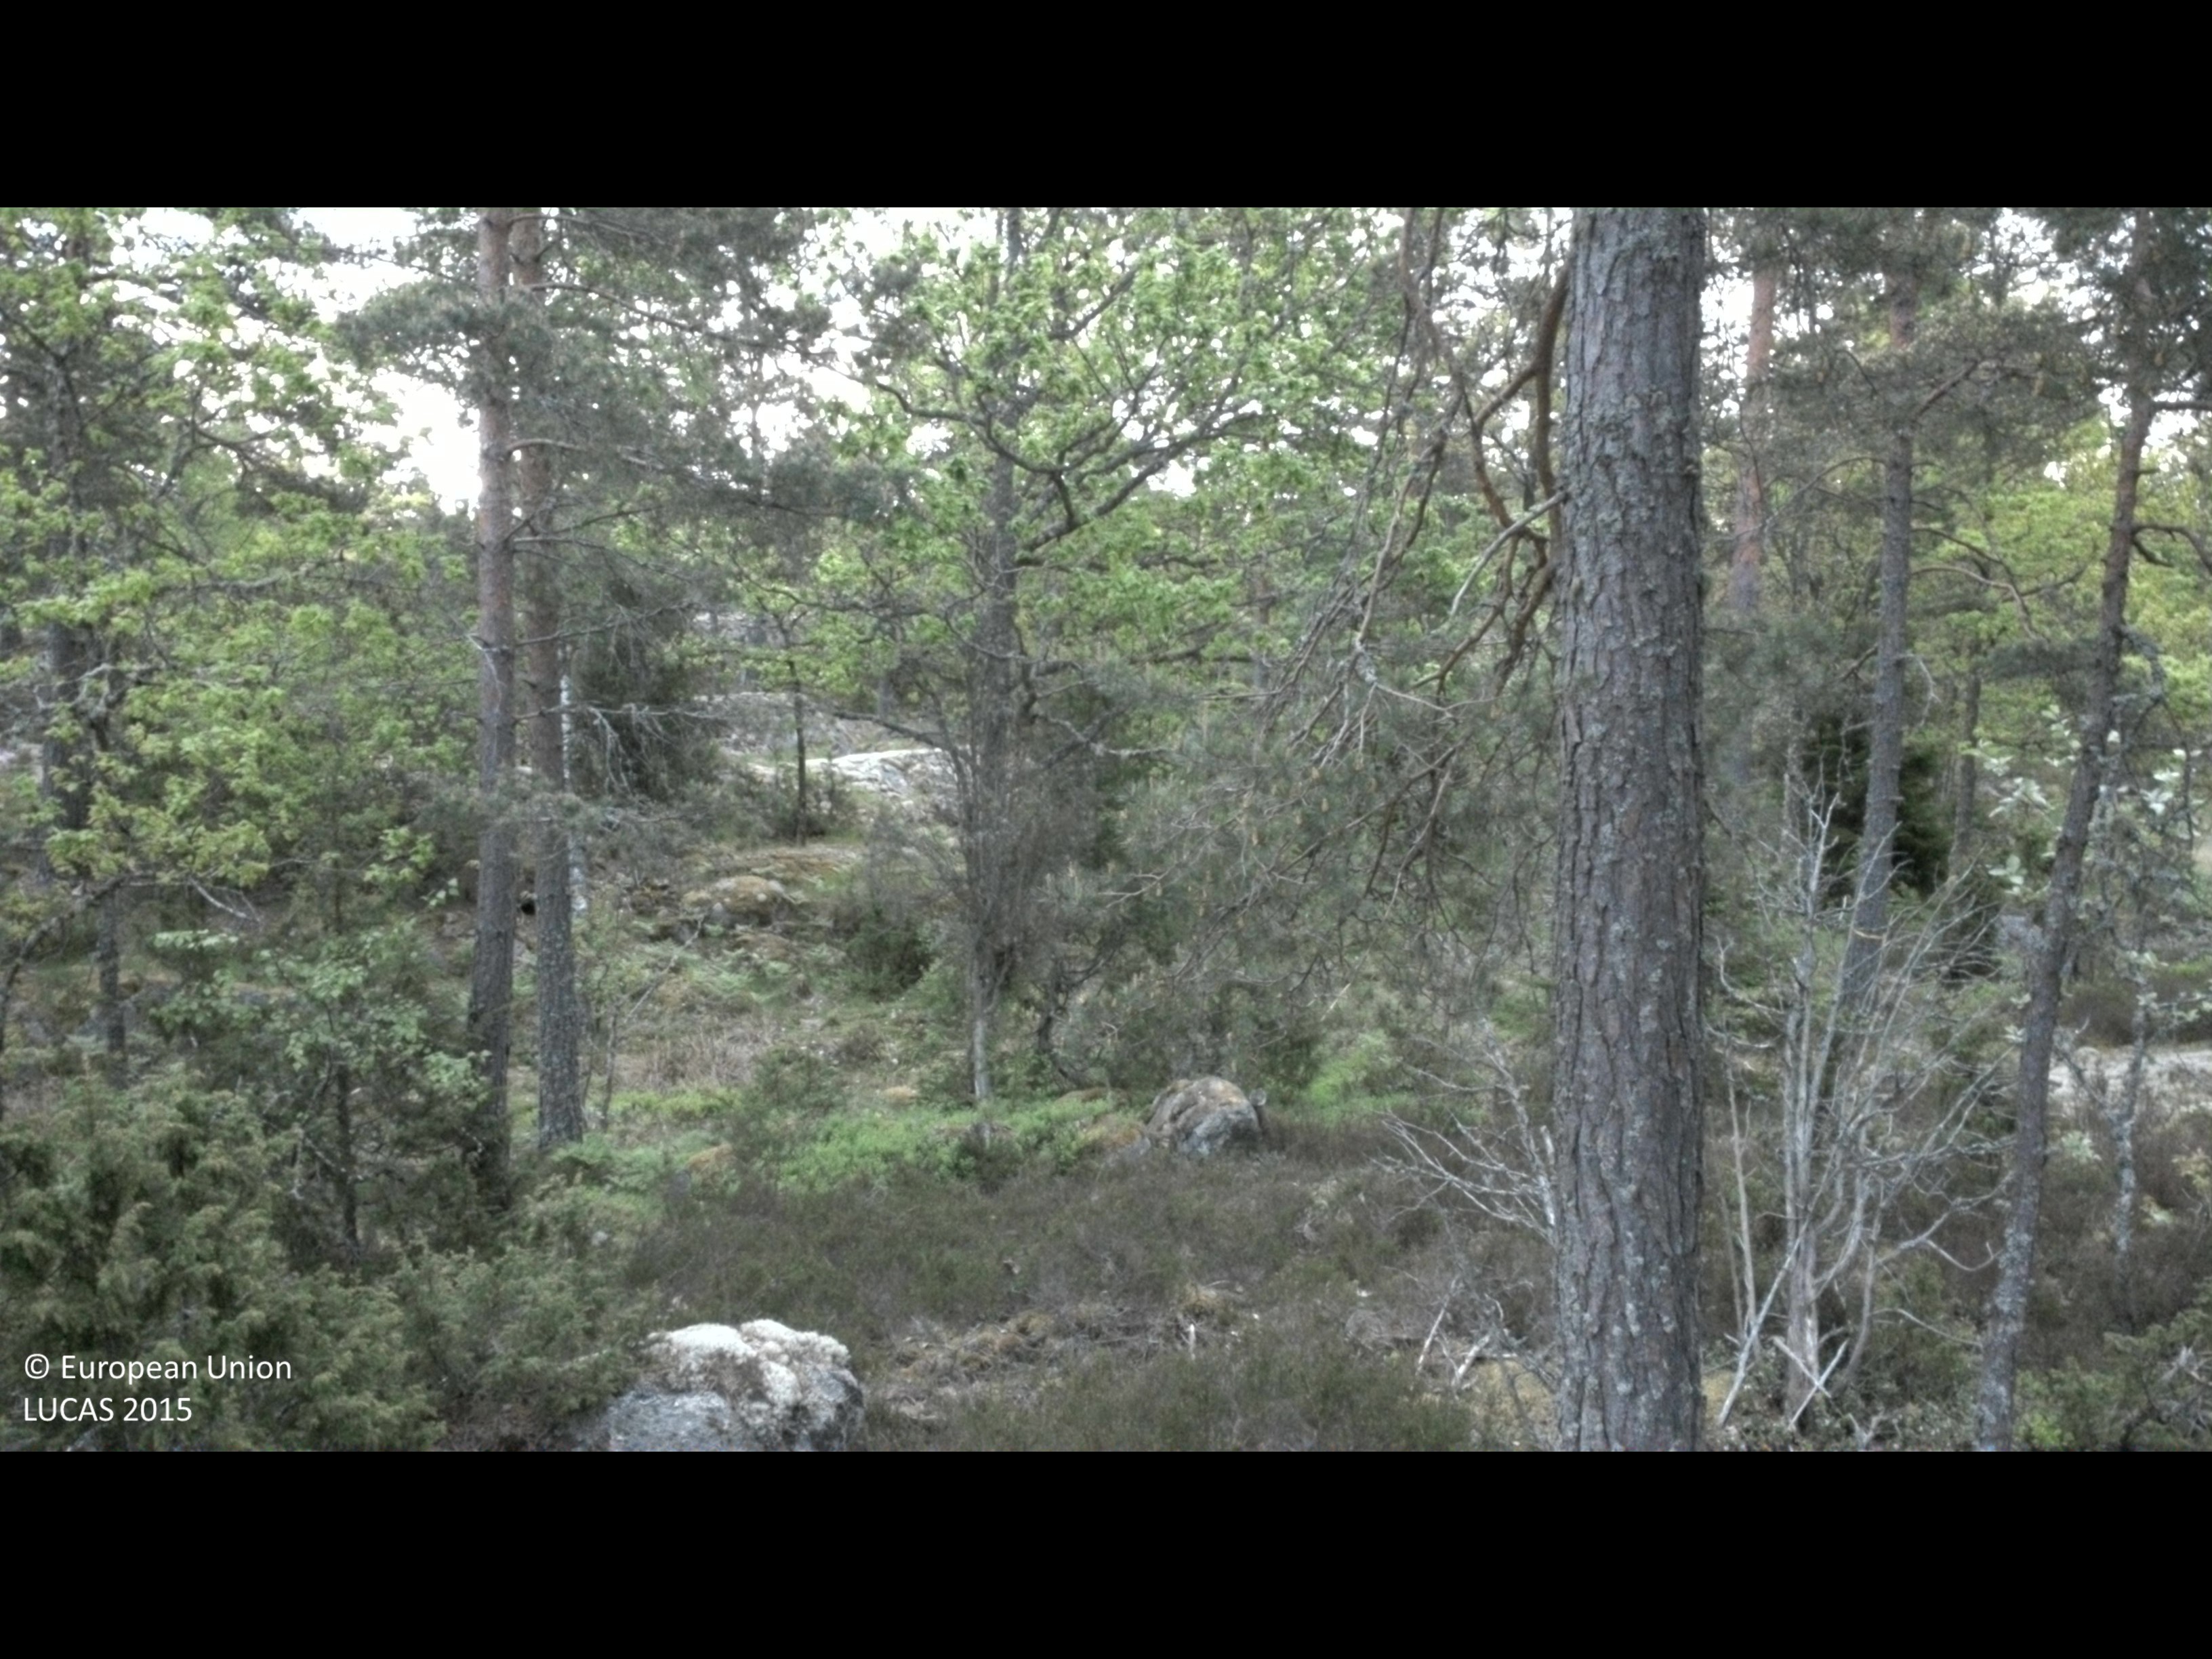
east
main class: Woodland
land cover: Pine dominated coniferous woodland
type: boreal forest
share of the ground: 50 - 75 %
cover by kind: coniferous forest trees 60 %, shrubs 20 %, lichens and mosses 15 %, broadleaved forest trees 5 %
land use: Forestry
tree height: > 5 m
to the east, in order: Pine dominated coniferous woodland; Pine dominated mixed woodland; Broadleaved woodland; Pine dominated coniferous woodland
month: May
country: SE
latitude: 57.4770
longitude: 16.6537
